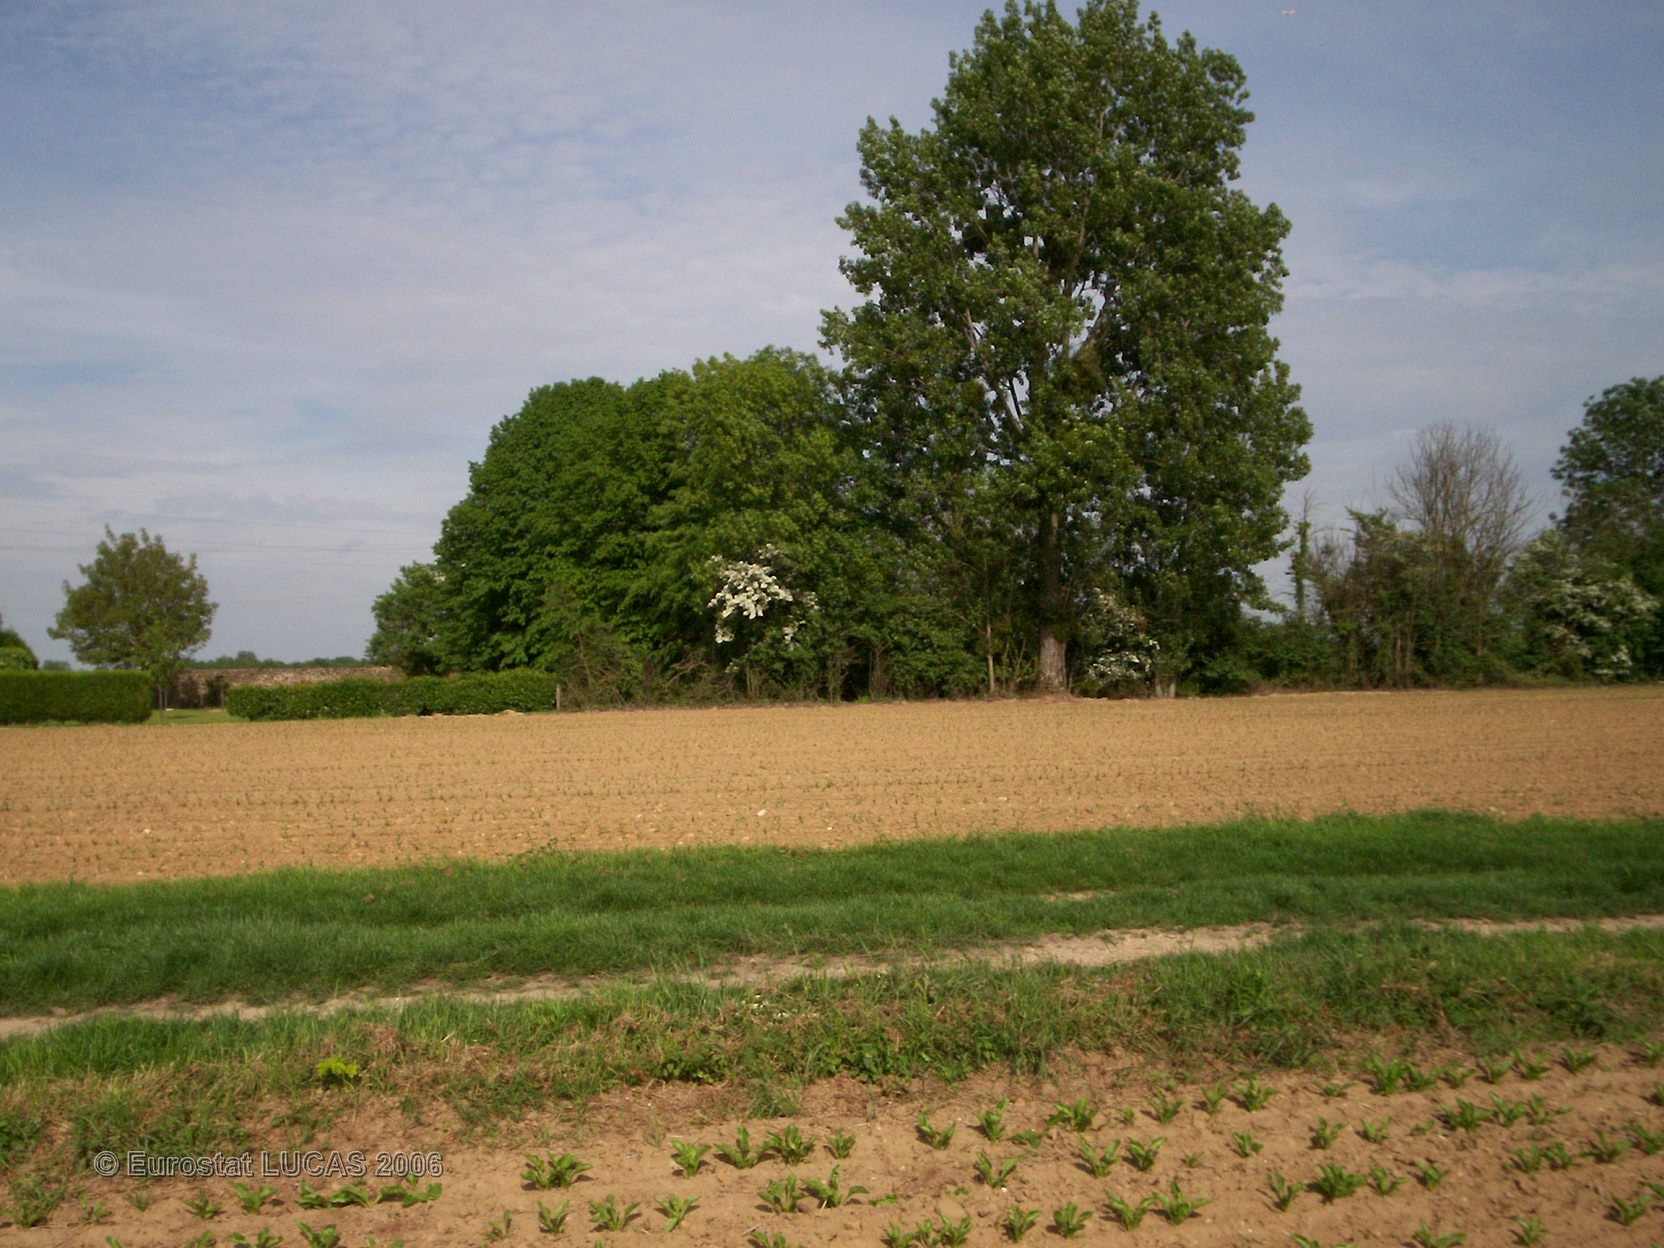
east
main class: Cropland
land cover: Sugar beet
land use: Agriculture (excluding fallow land and kitchen gardens)
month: May
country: FR
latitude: 48.6425
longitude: 2.8658
